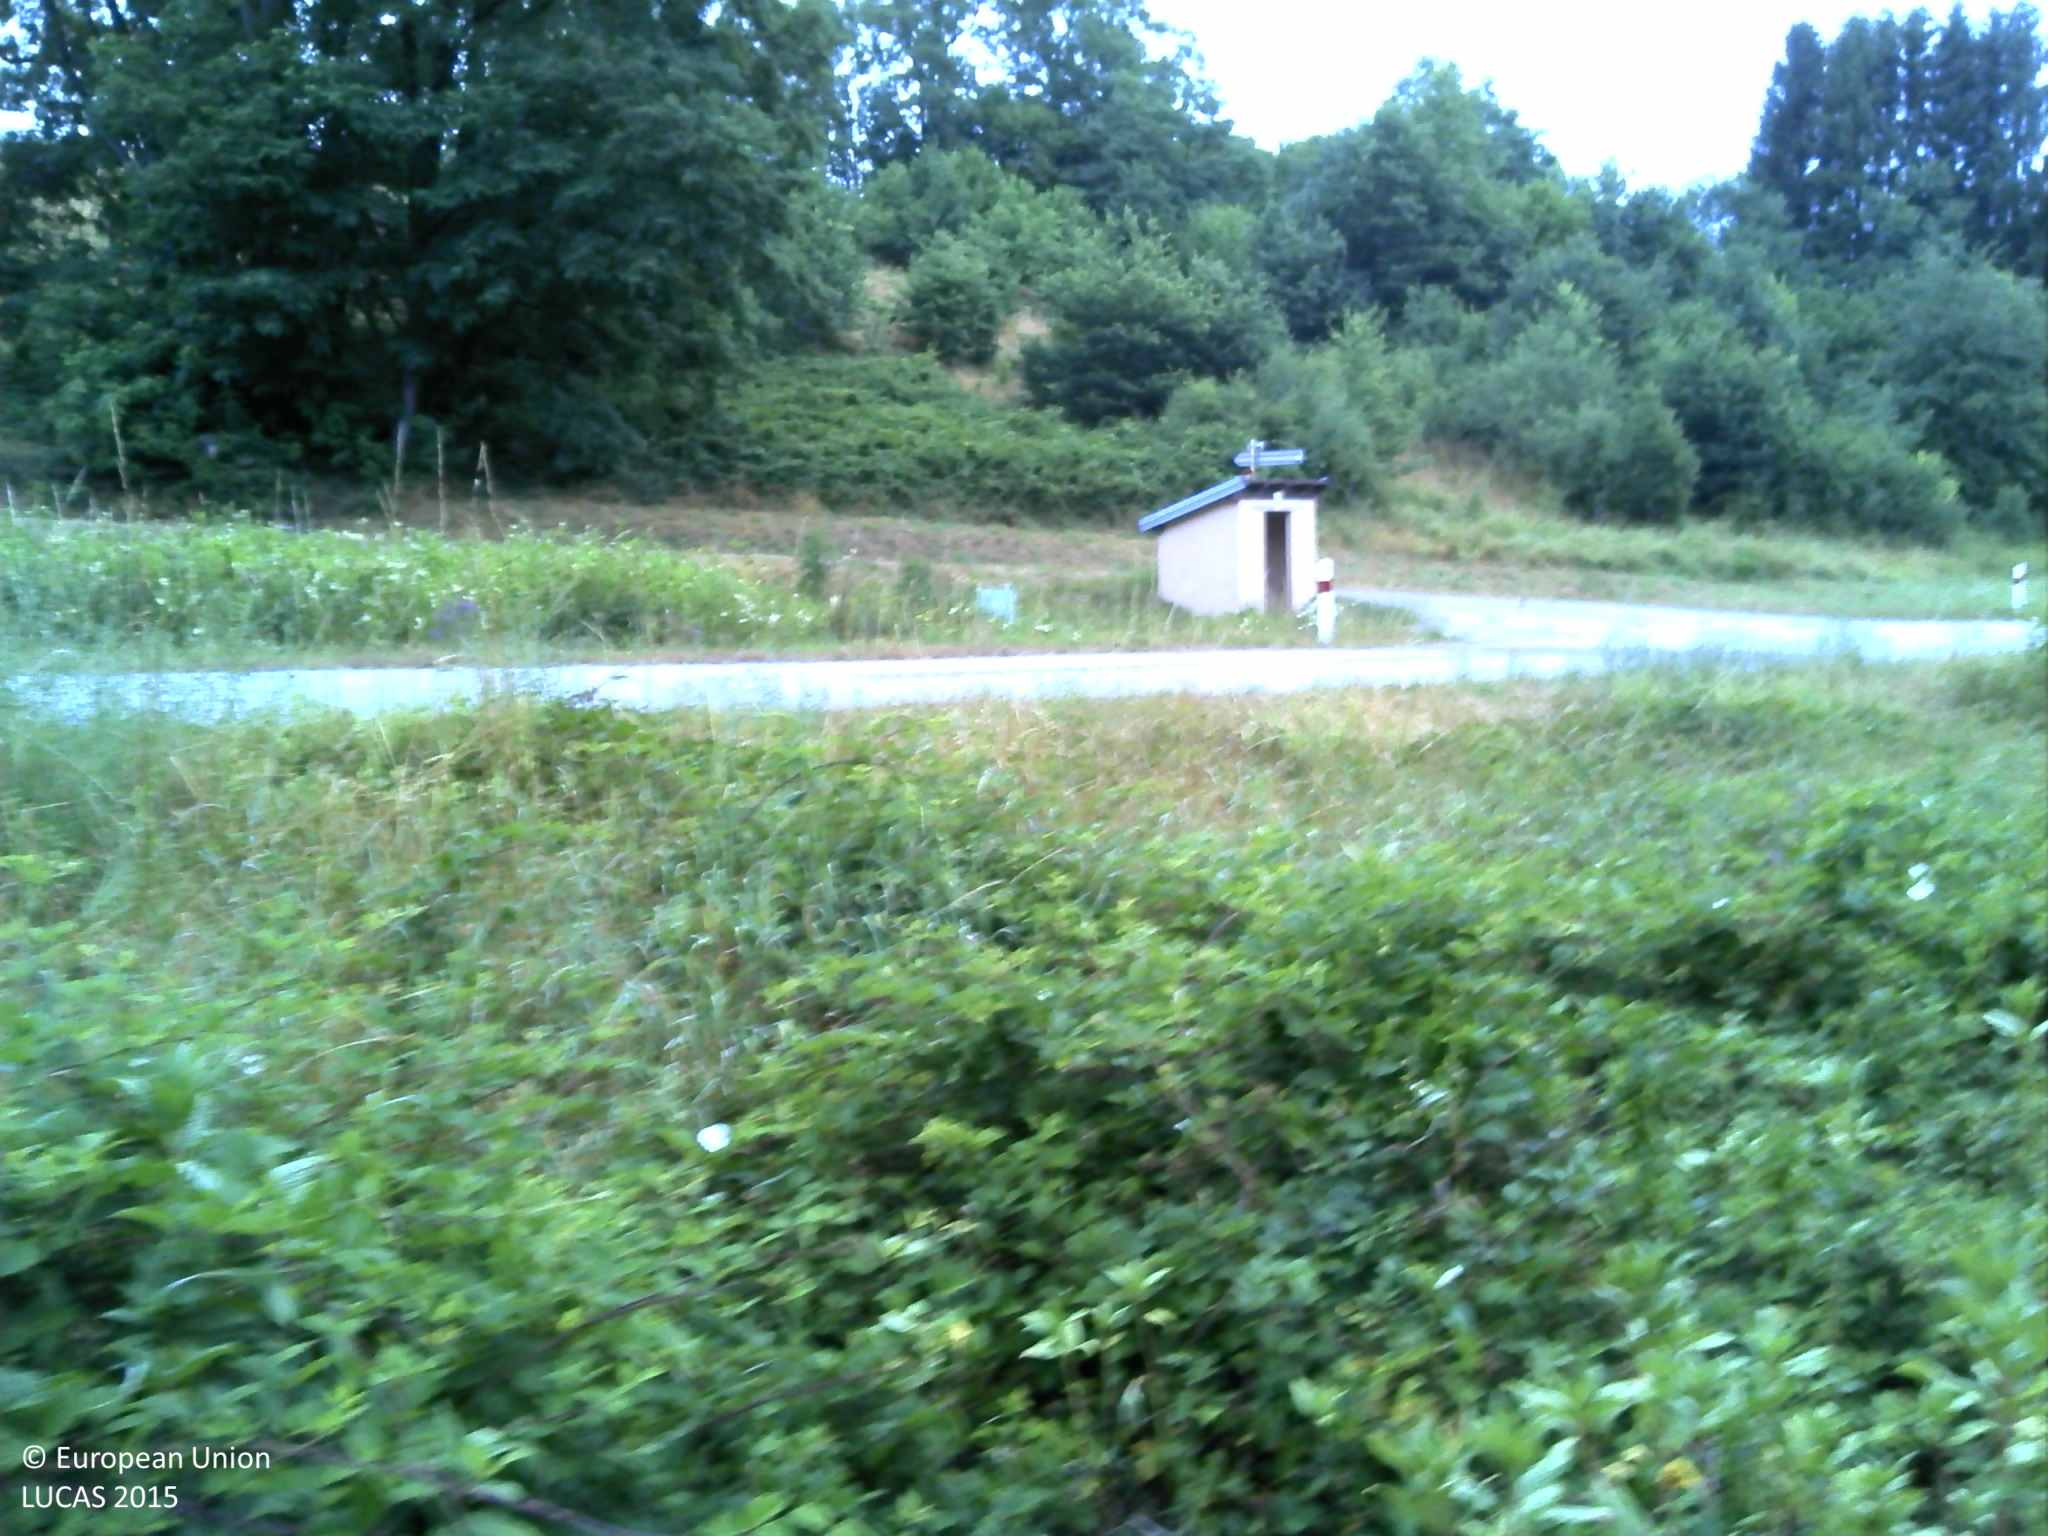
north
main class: Shrubland
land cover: Shrubland with sparse tree cover
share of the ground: > 75 %
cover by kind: shrubs 95 %, broadleaved forest trees 5 %
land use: Semi-natural and natural areas not in use
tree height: < 5 m
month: July
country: FR
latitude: 48.0520
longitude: 6.2577
